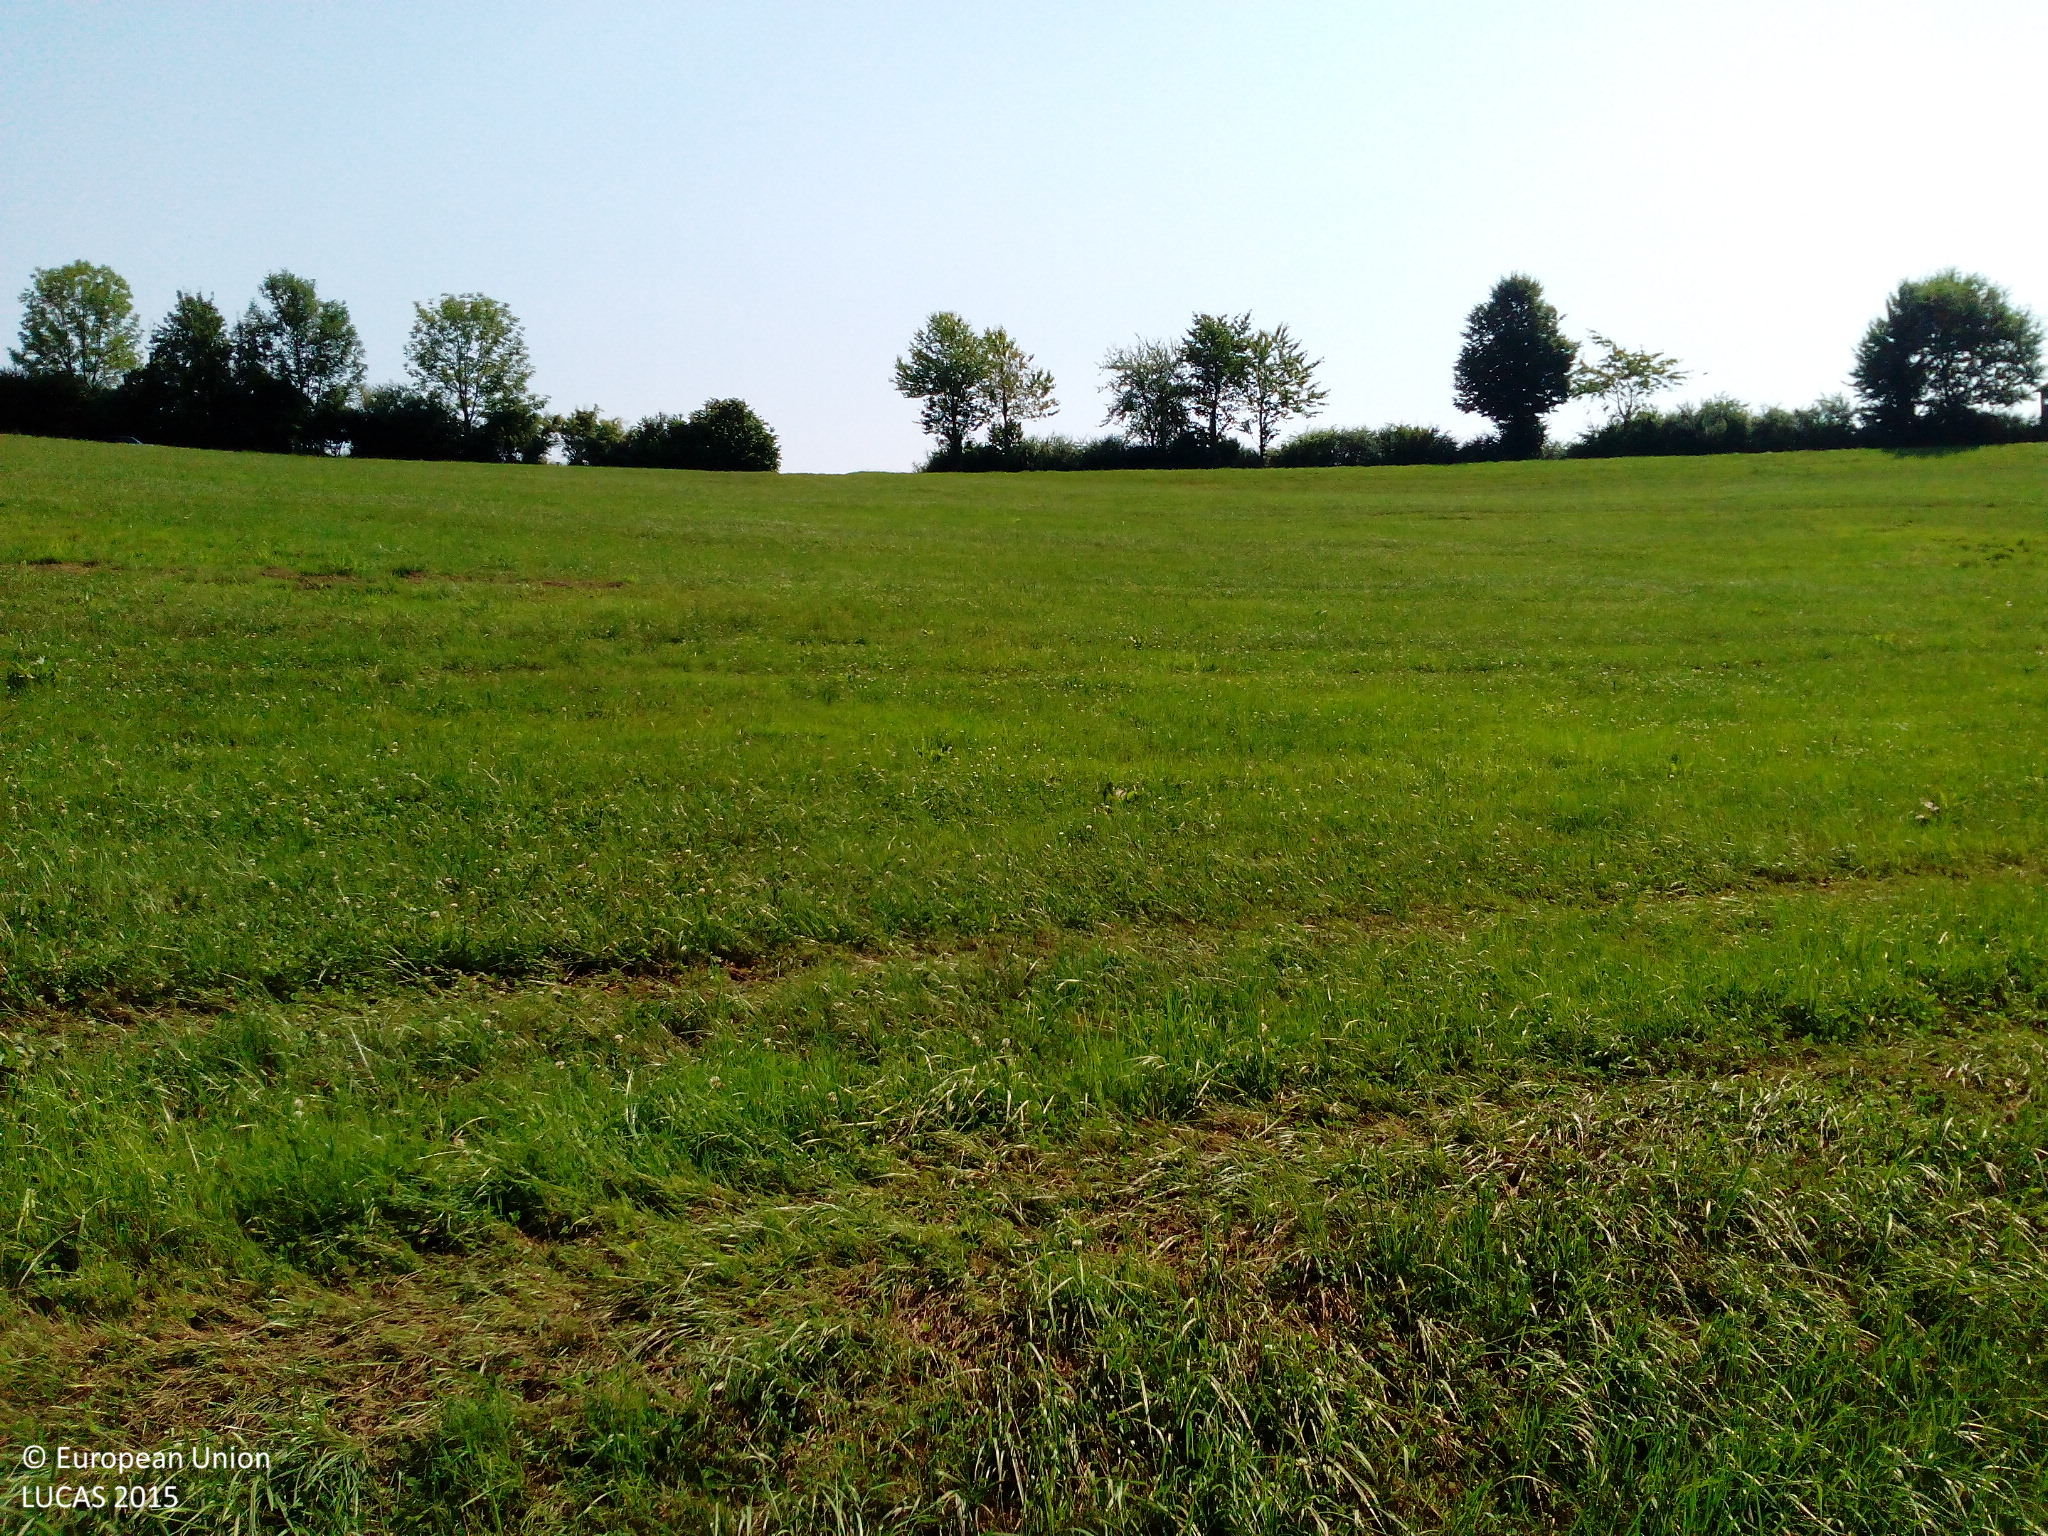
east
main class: Grassland
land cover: Grassland without tree/shrub cover
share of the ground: > 75 %
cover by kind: herbaceous plants 100 %
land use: Agriculture (excluding fallow land and kitchen gardens)
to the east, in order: Grassland without tree/shrub cover; Paved roads, cycling and walking lanes; Grass margins; Lines of trees; Barley; Grassland without tree/shrub cover
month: July
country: DE
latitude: 48.2756
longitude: 12.8960
